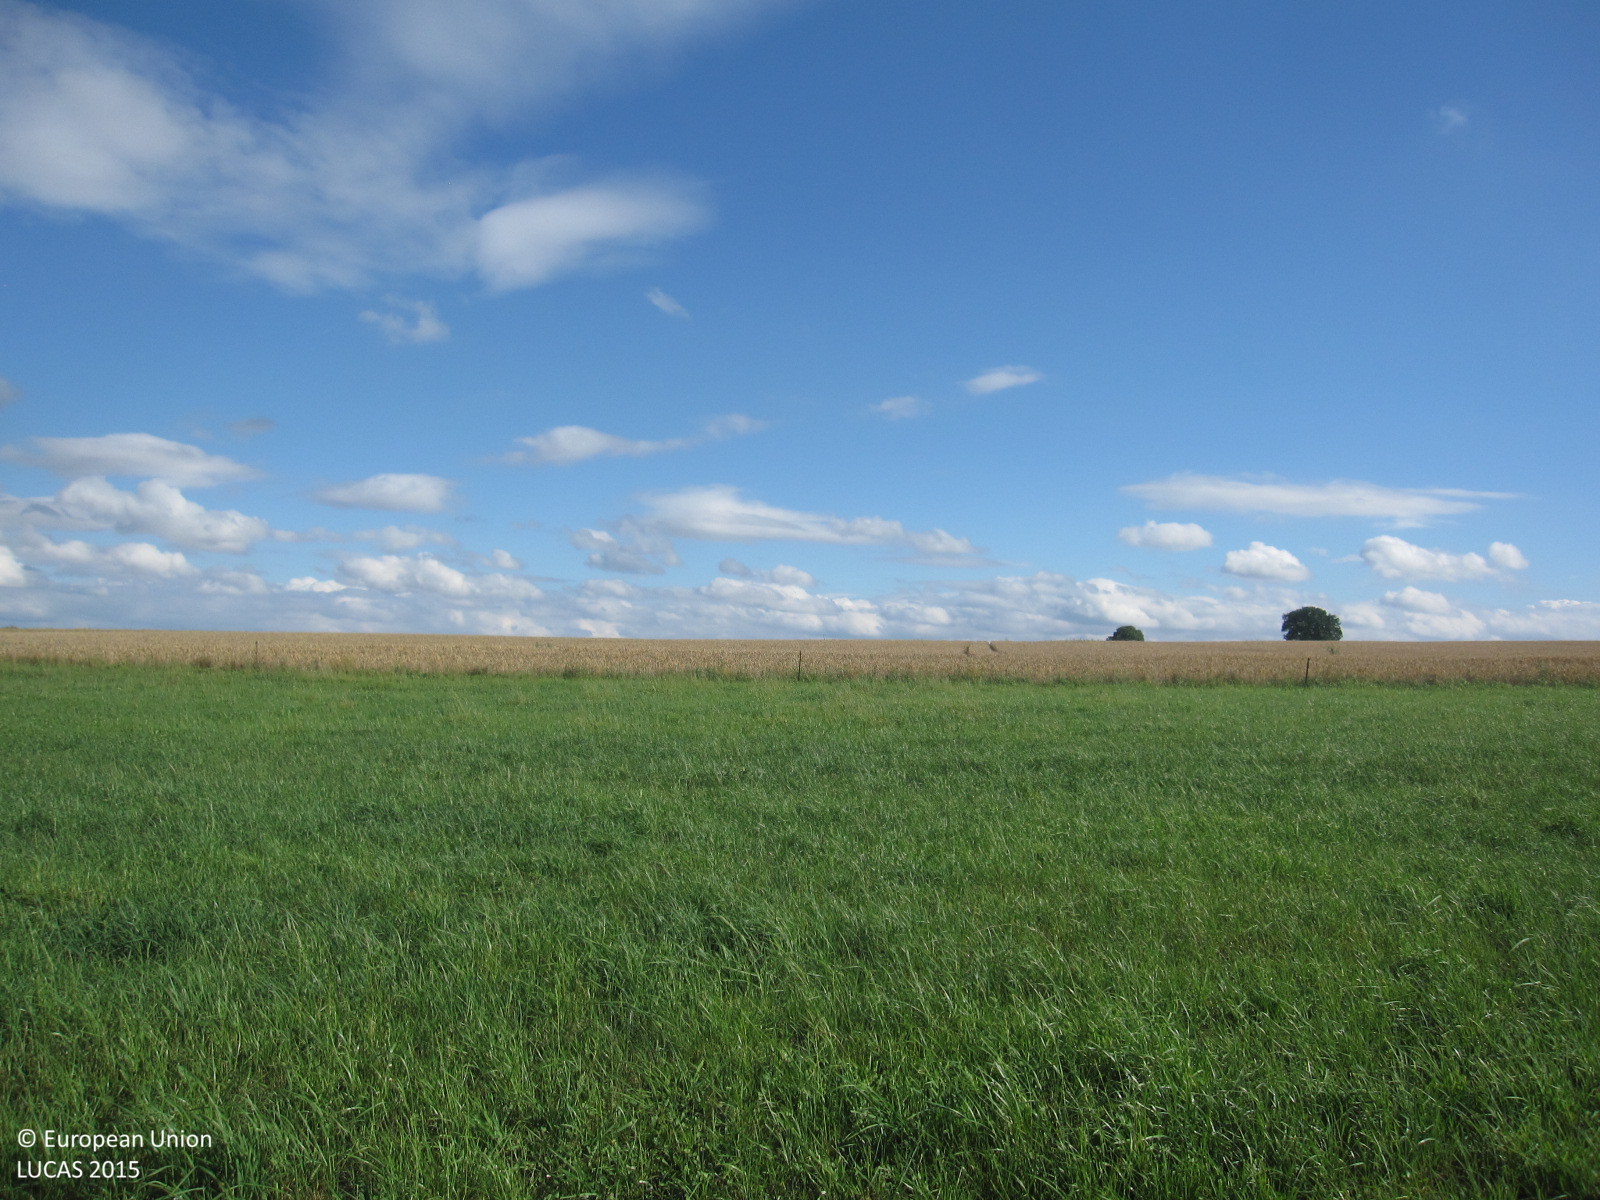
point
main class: Cropland
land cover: Common wheat
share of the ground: > 75 %
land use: Agriculture (excluding fallow land and kitchen gardens)
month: July
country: DE
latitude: 50.9570
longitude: 12.0640
